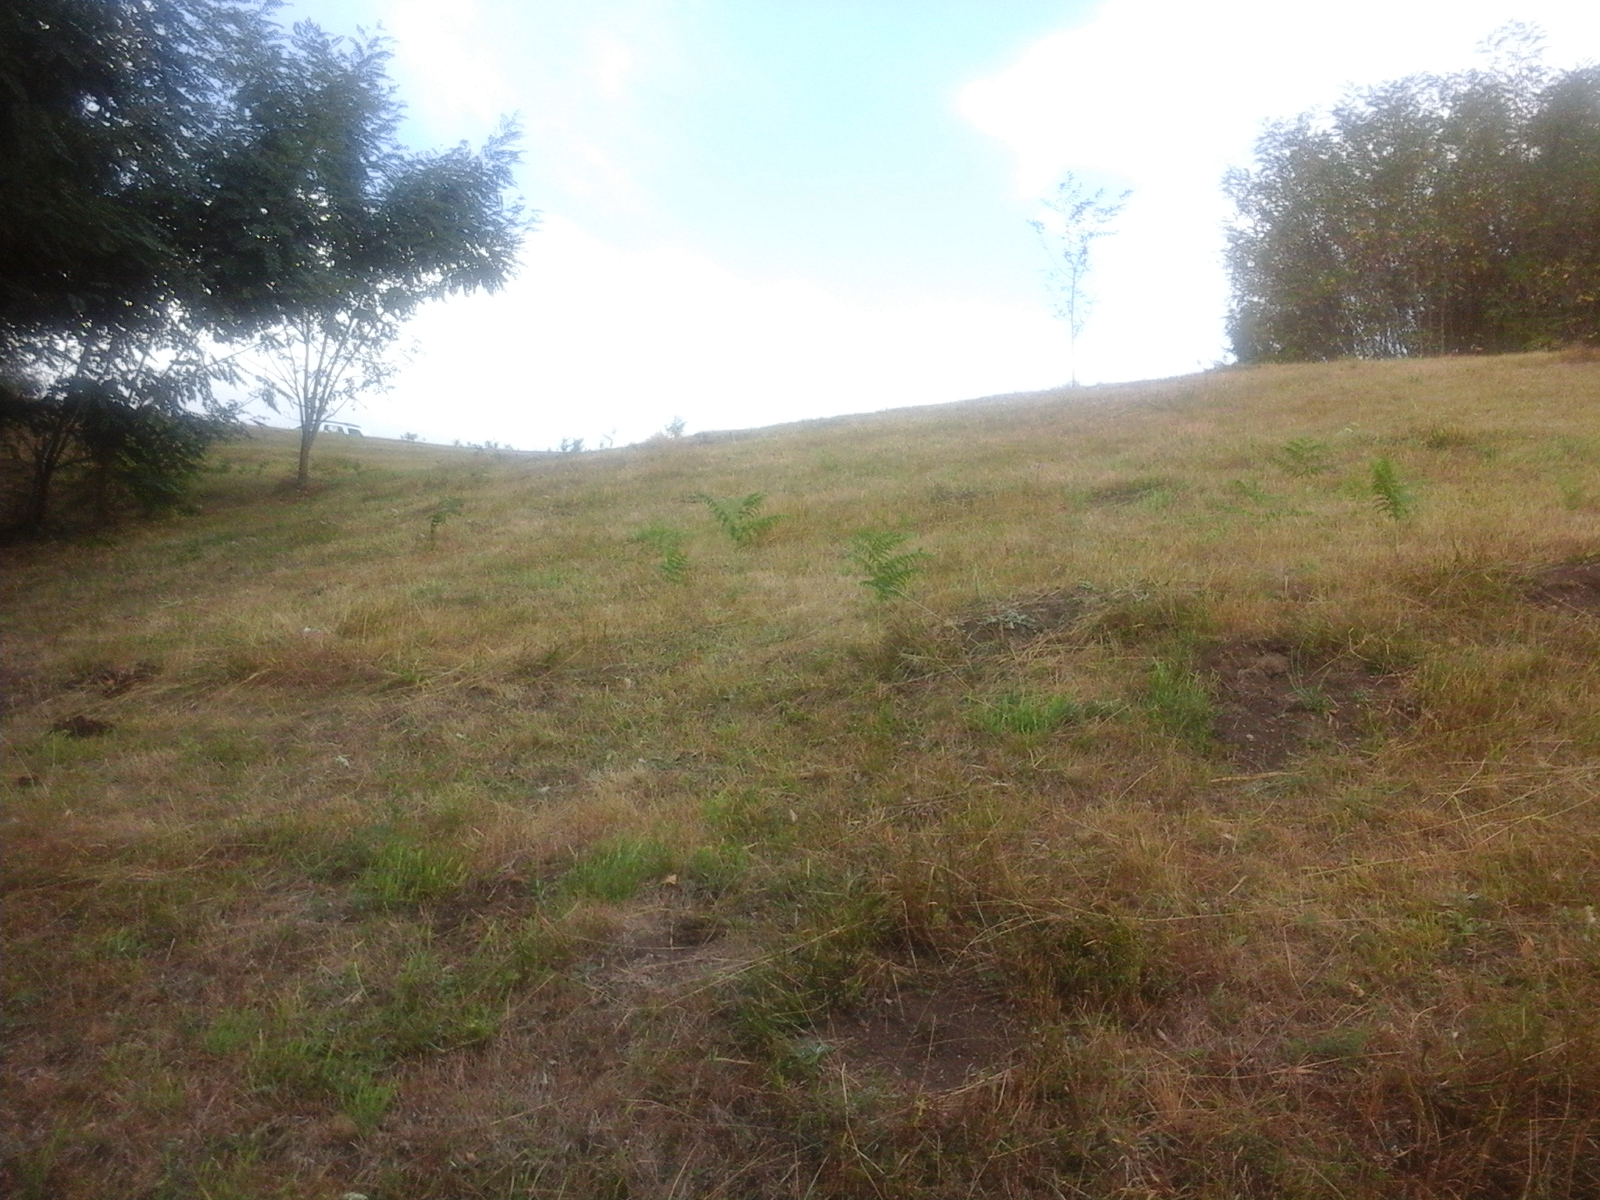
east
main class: Woodland
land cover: Broadleaved woodland
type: exotic forest
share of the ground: > 75 %
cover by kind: broadleaved forest trees 100 %
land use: Forestry
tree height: > 5 m
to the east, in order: Broadleaved woodland; Grassland without tree/shrub cover; Tracks; Grassland without tree/shrub cover; Grassland with sparse tree/shrub cover
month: August
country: RO
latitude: 44.9873
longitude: 22.7153
